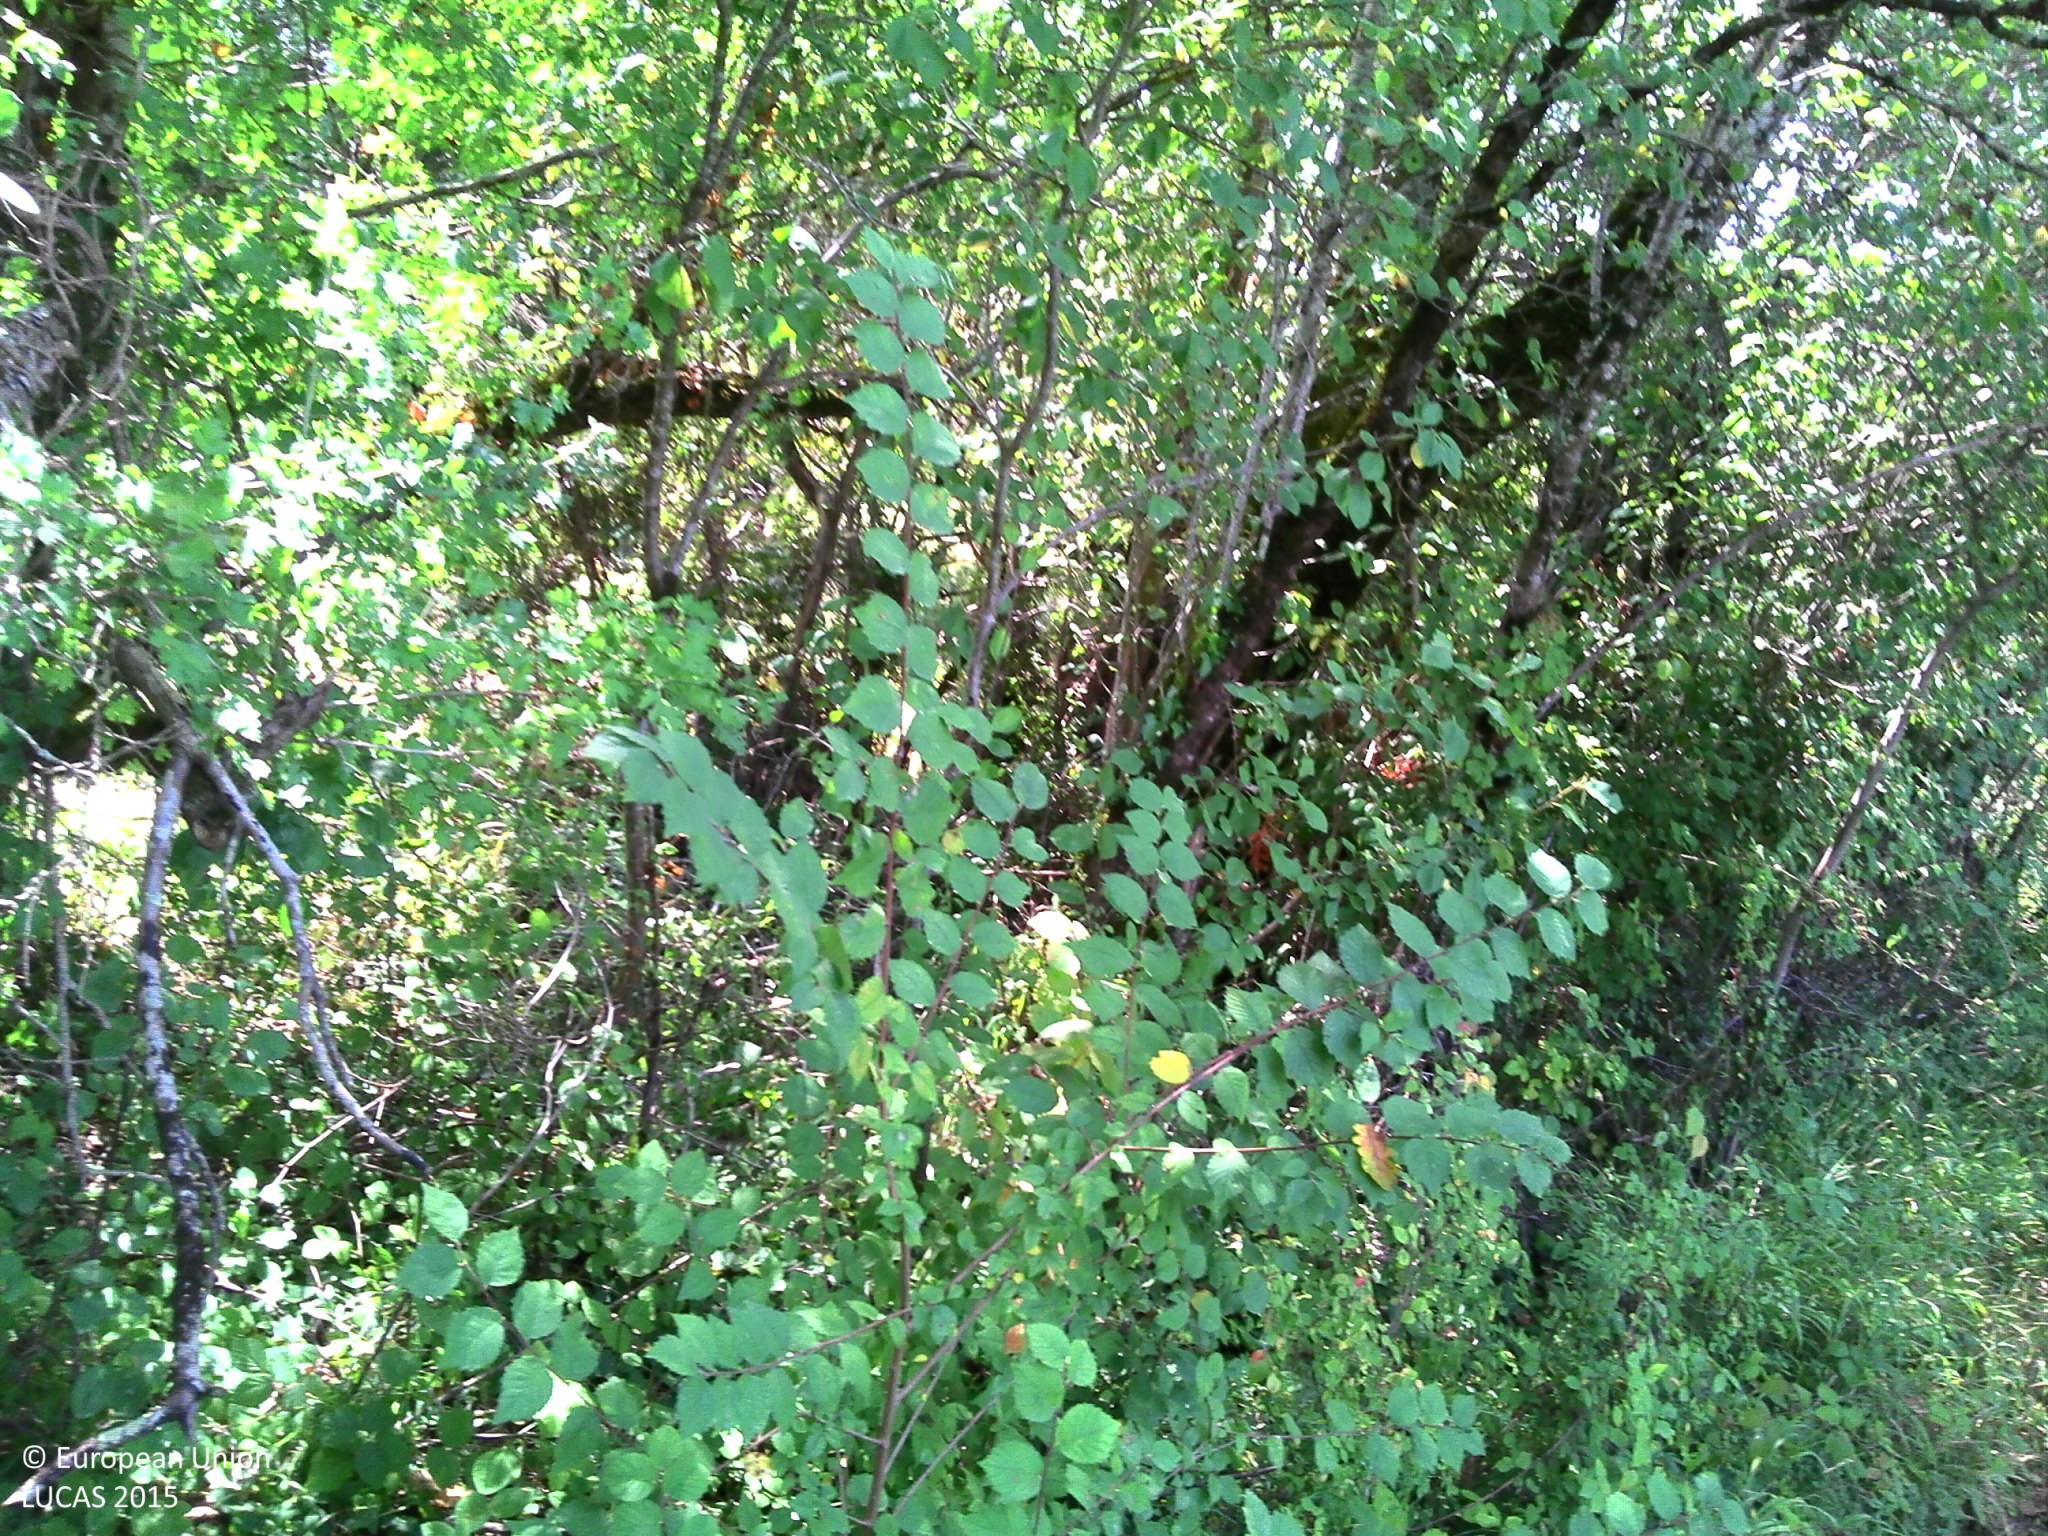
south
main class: Cropland
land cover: Maize
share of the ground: > 75 %
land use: Agriculture (excluding fallow land and kitchen gardens)
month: August
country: FR
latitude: 44.2189
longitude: 1.5006
